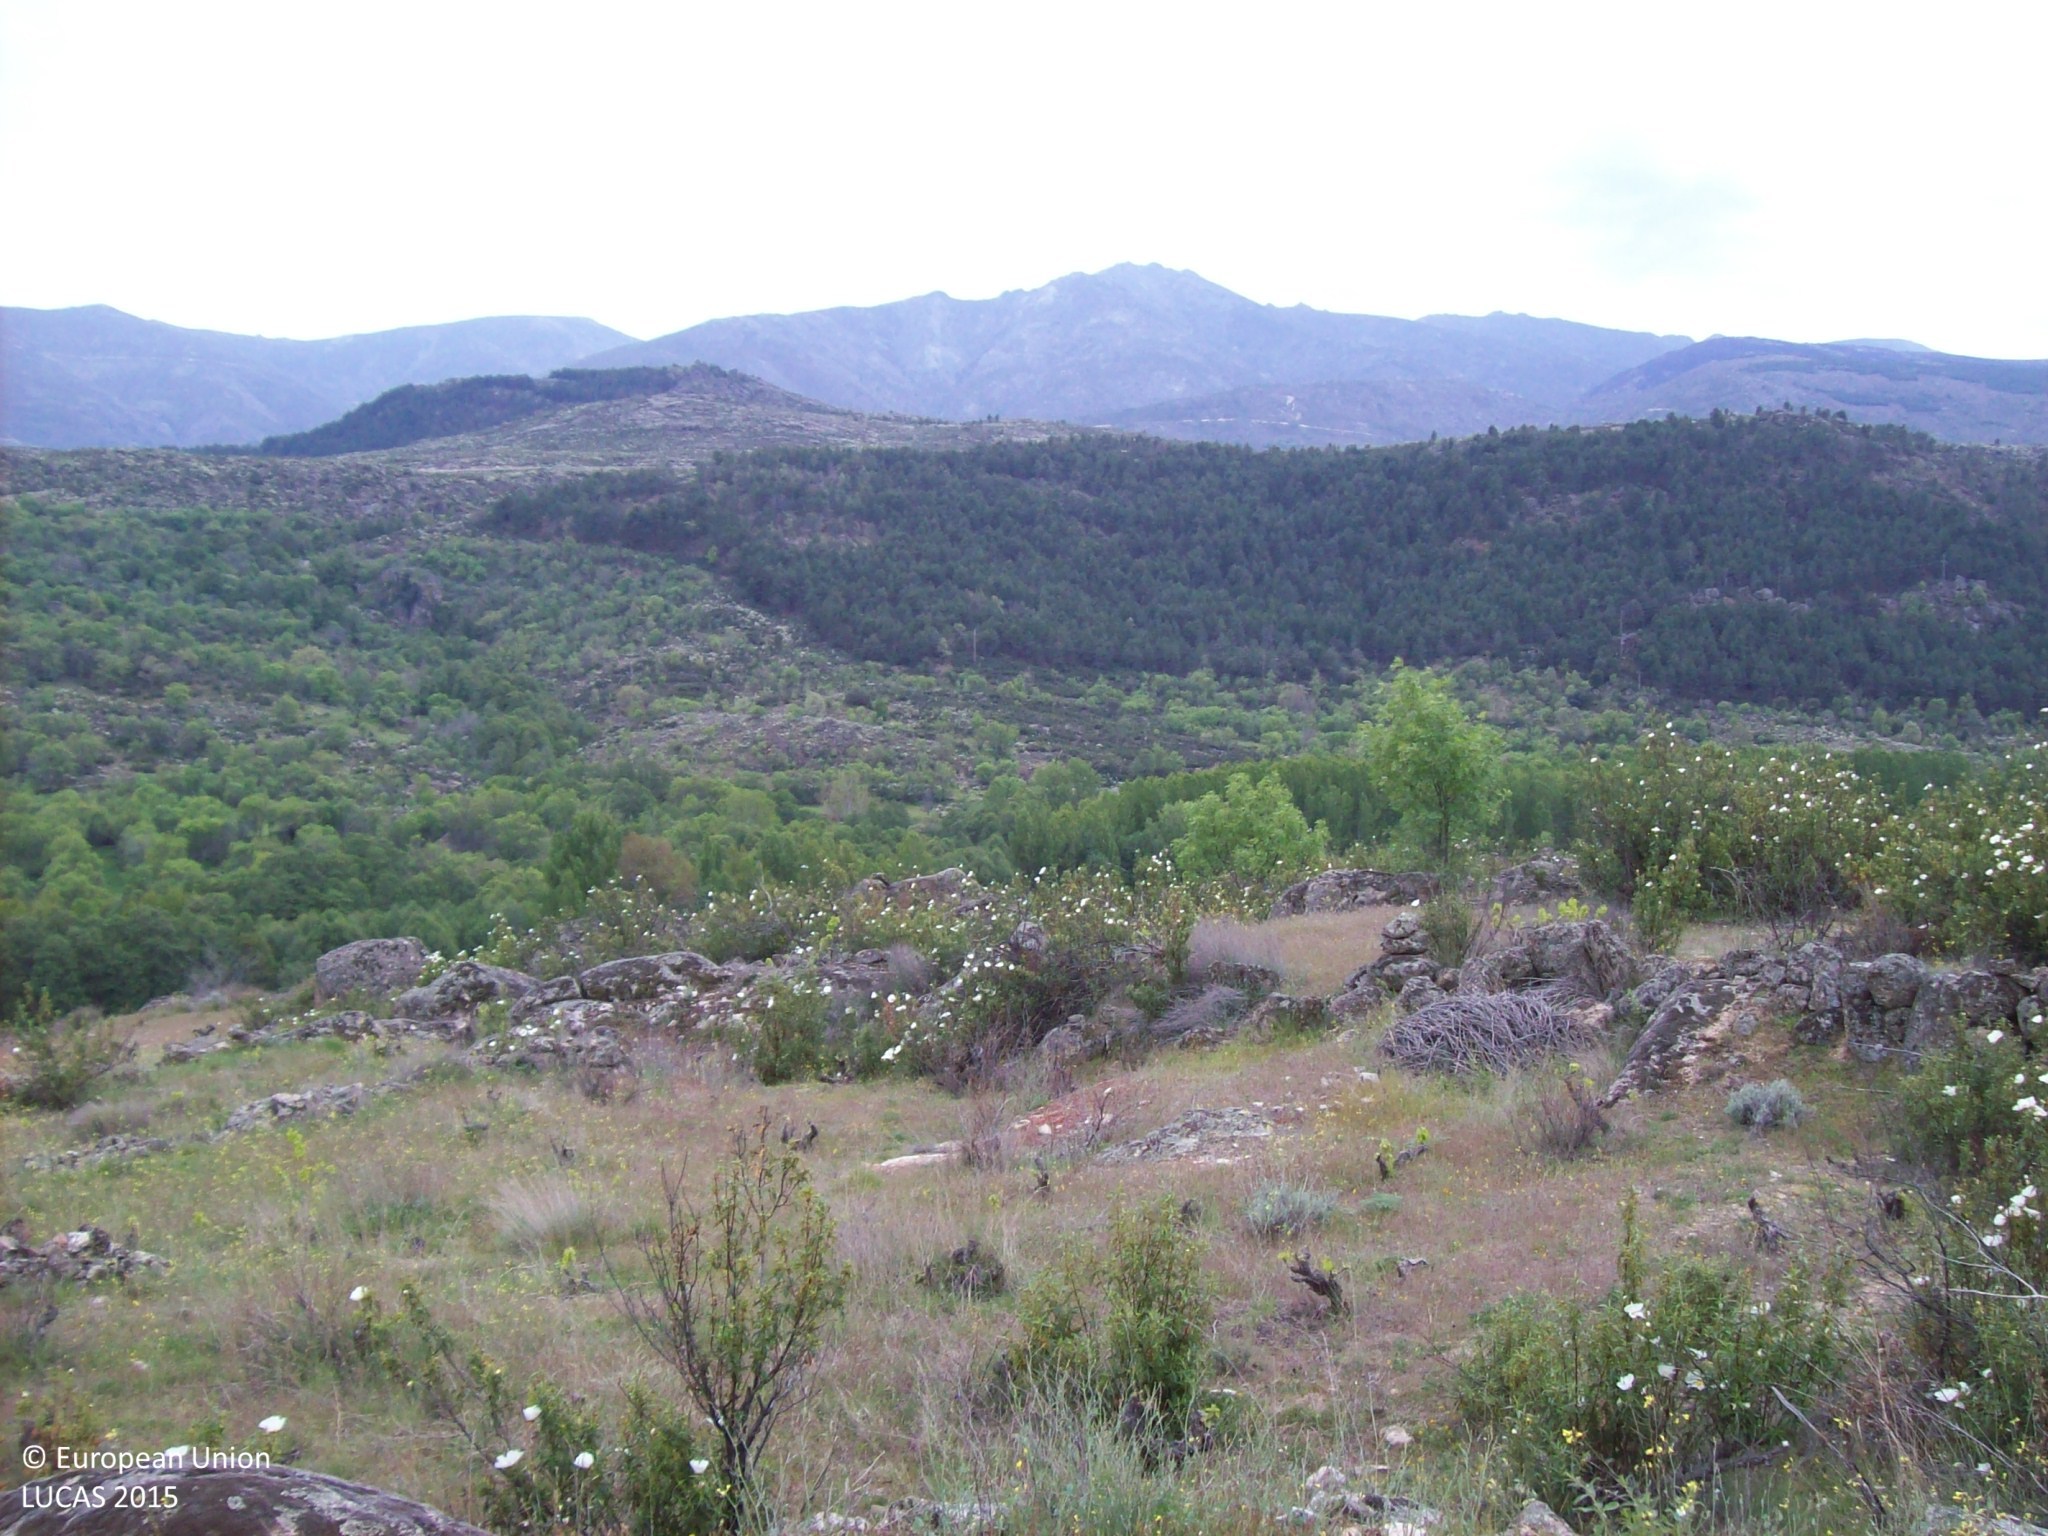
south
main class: Cropland
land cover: Vineyards
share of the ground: 10 - 25 %
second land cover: Shrubland without tree cover
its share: 25 - 50 %
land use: Abandoned areas
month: April
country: ES
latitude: 40.4018
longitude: -4.8175
